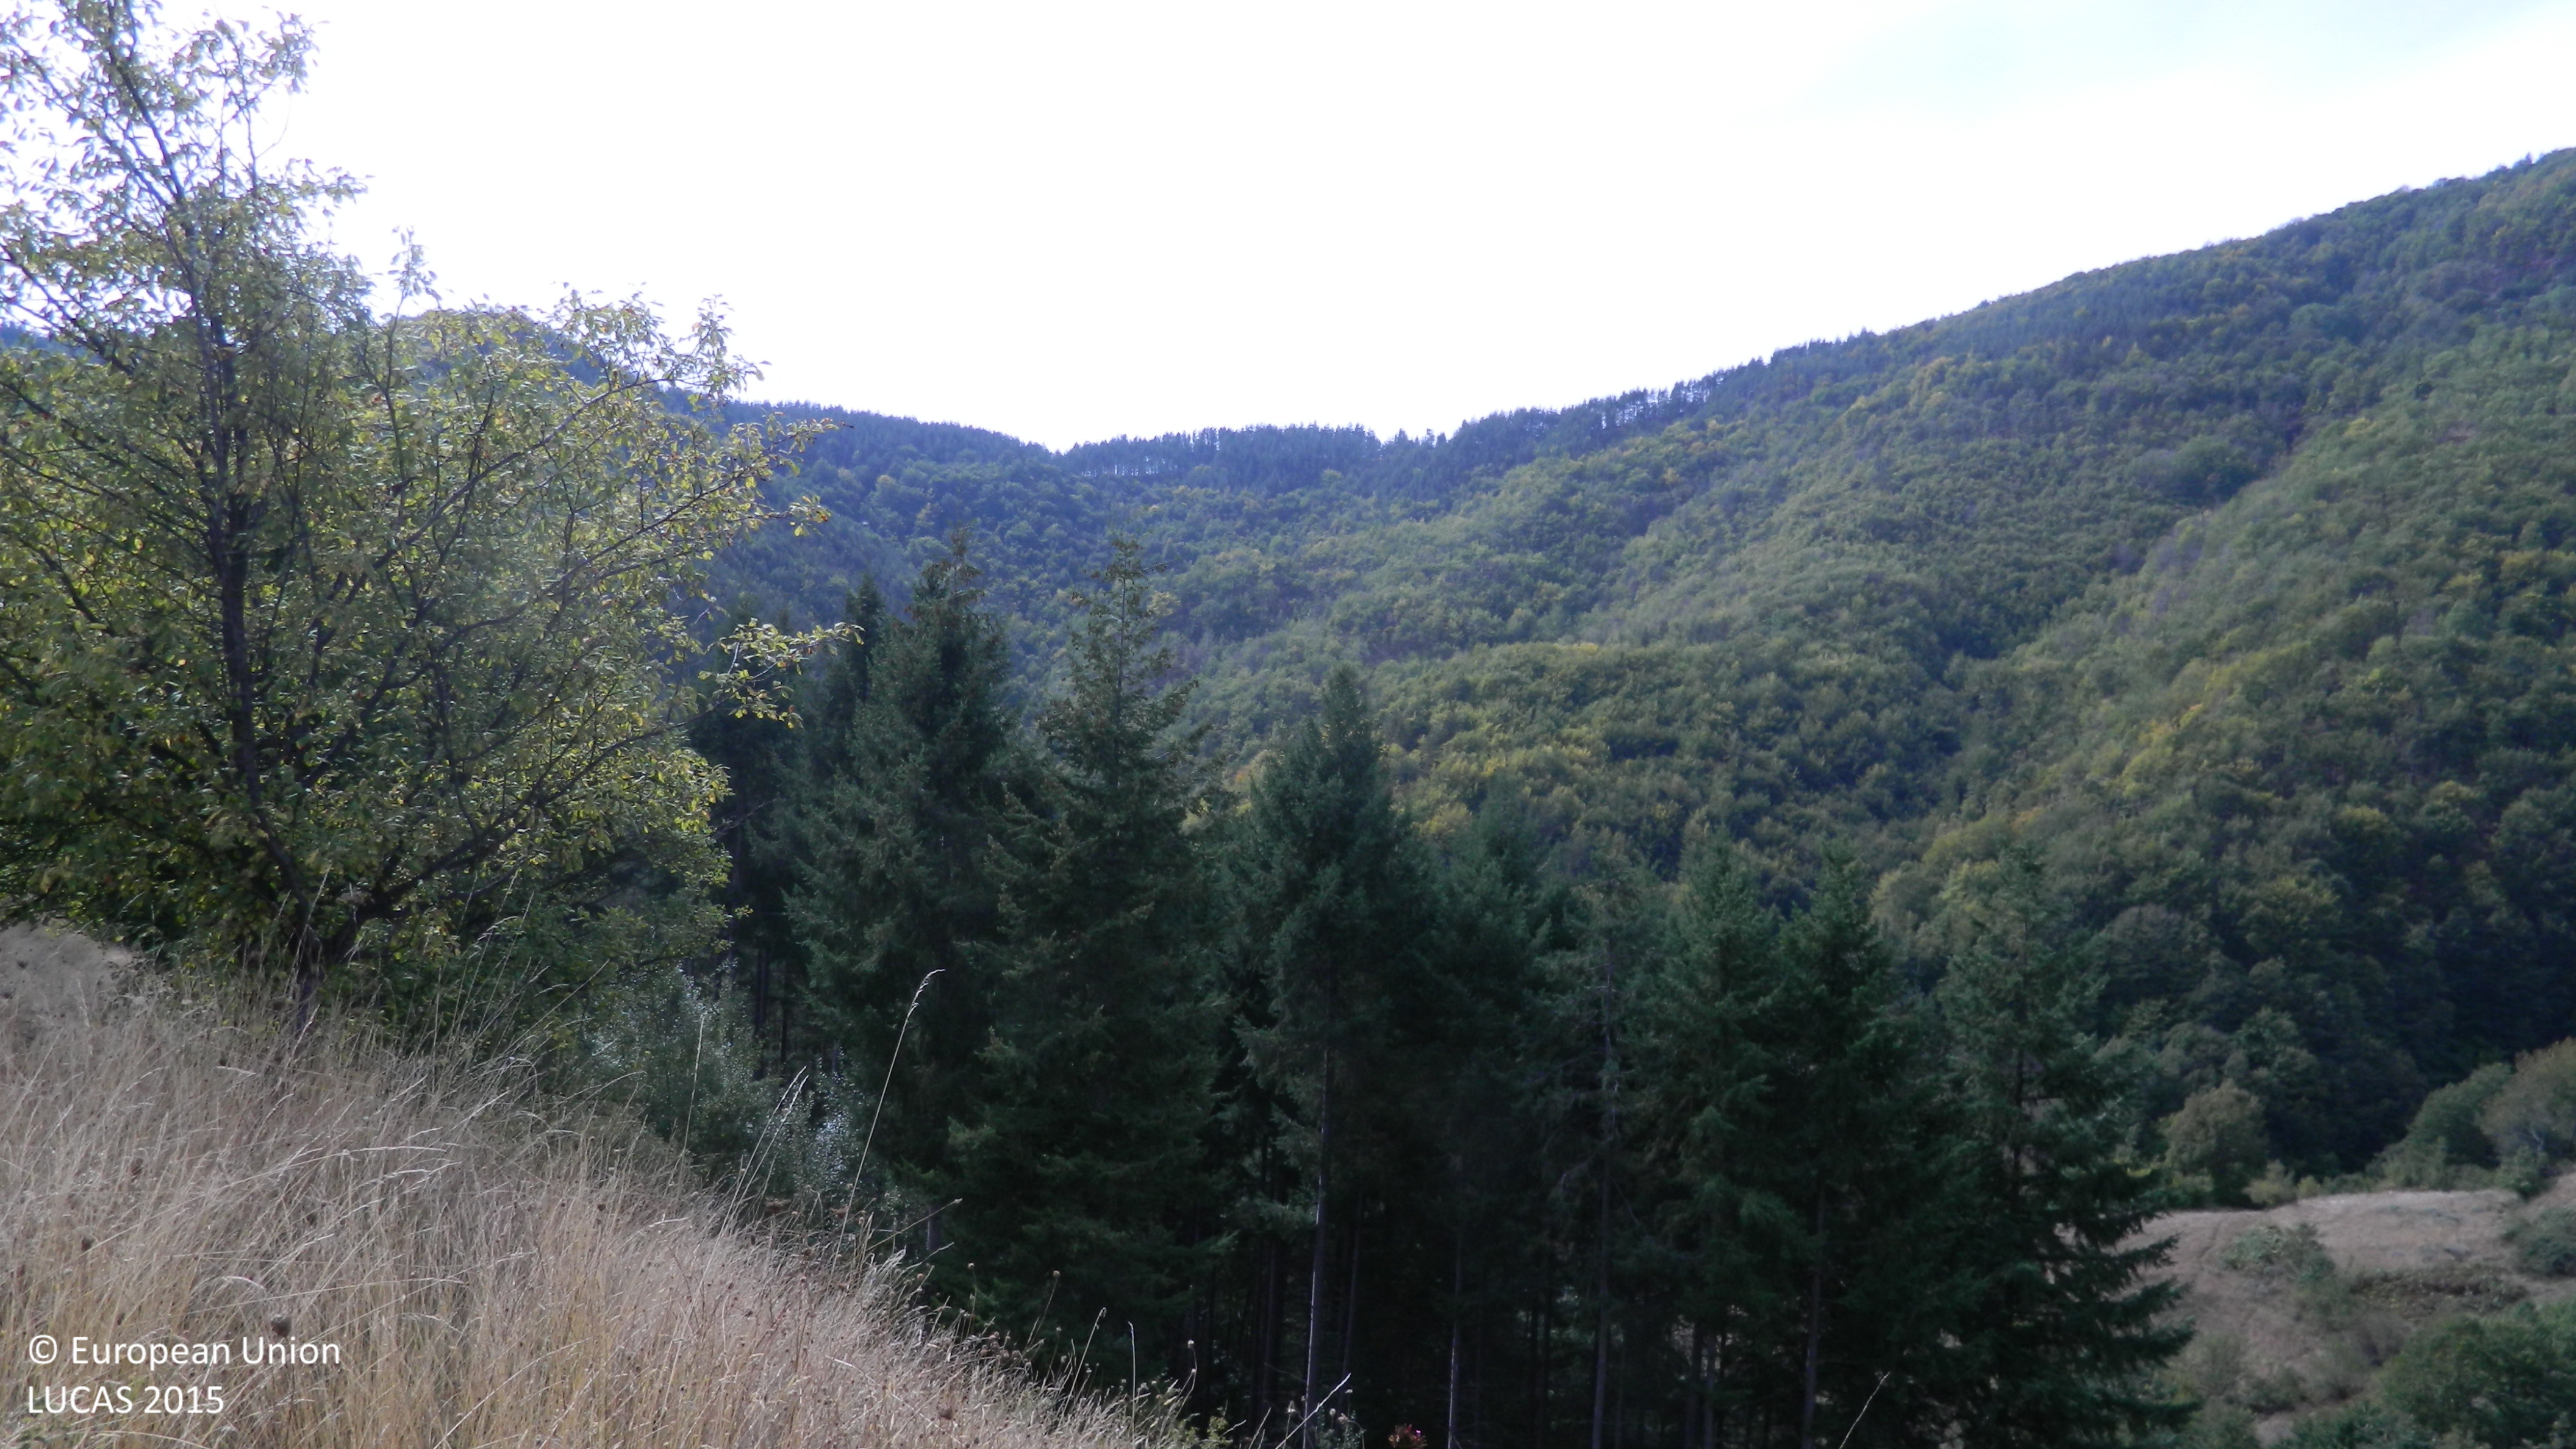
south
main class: Woodland
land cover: Pine dominated mixed woodland
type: hemiboreal forest and nemoral coniferous forest and mixed broadleaved-coniferous forest
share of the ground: > 75 %
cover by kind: coniferous forest trees 75 %, broadleaved forest trees 25 %
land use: Forestry
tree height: > 5 m
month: October
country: BG
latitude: 41.5838
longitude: 24.8848
